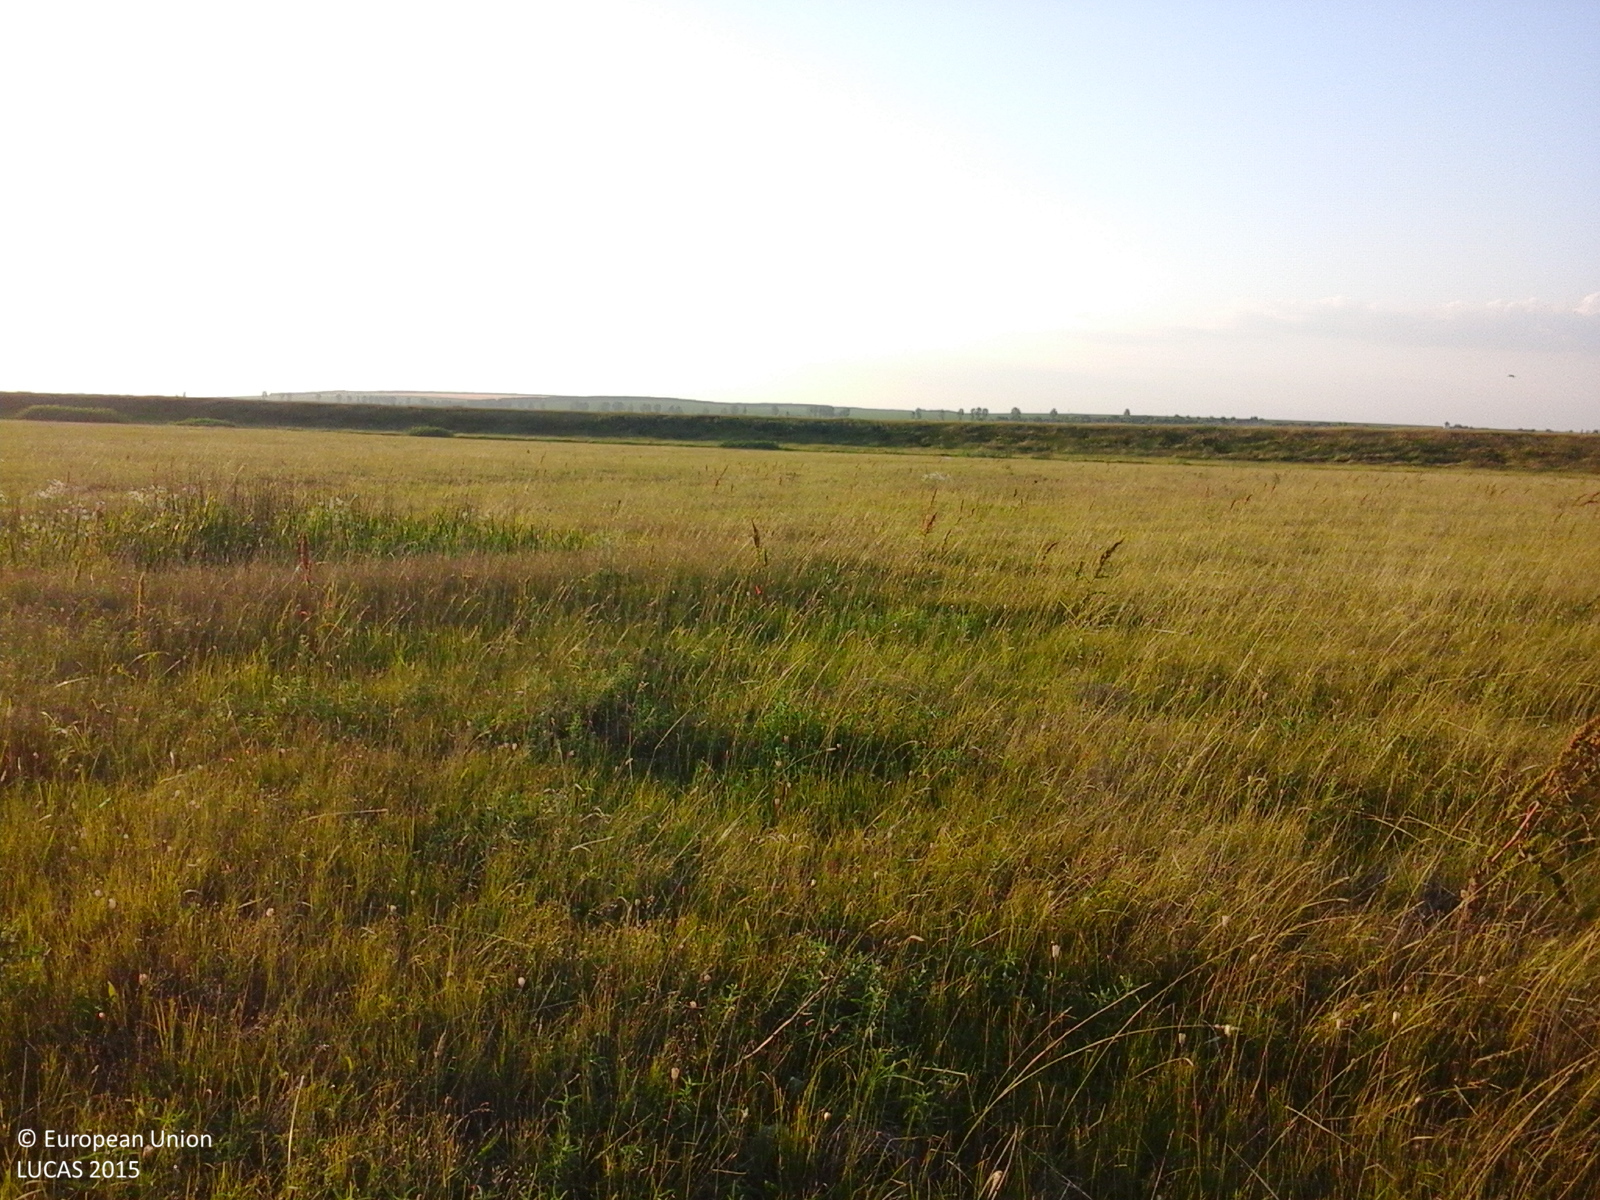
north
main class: Grassland
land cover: Grassland without tree/shrub cover
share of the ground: > 75 %
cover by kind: herbaceous plants 100 %
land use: Agriculture (excluding fallow land and kitchen gardens)
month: June
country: RO
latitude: 47.3129
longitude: 27.4580
